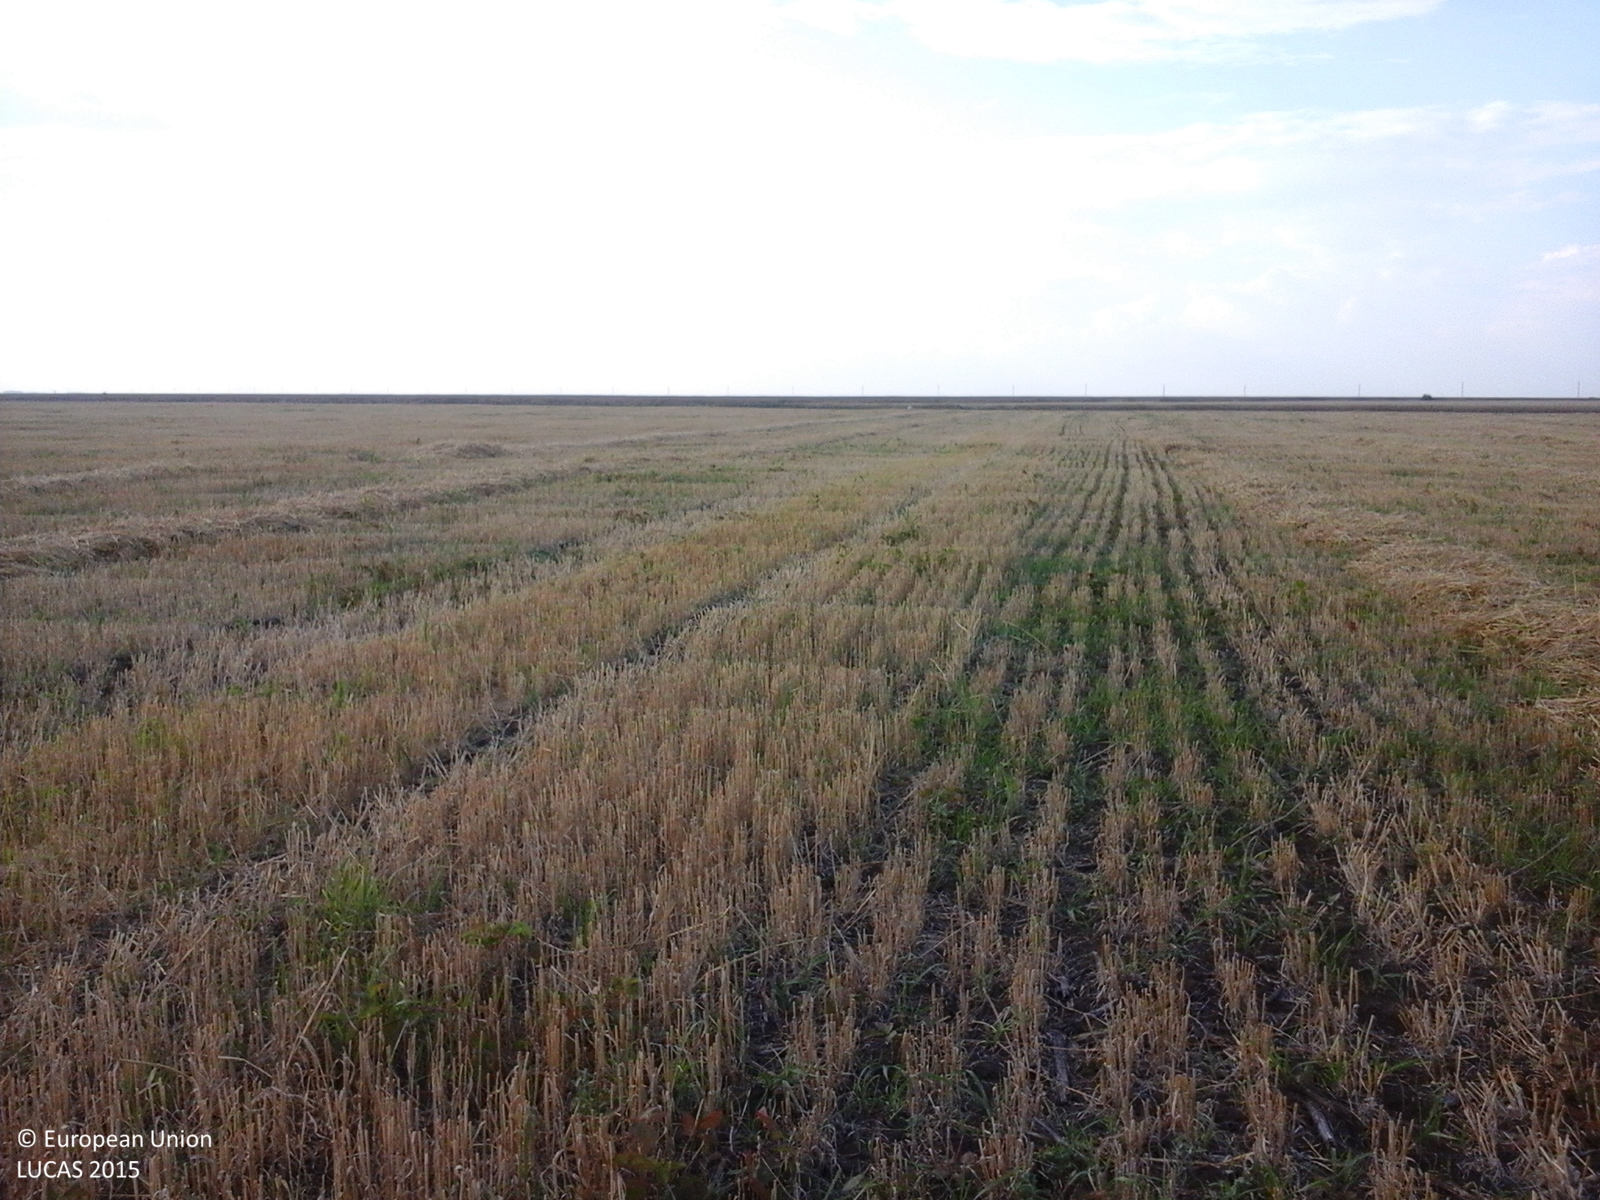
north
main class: Cropland
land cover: Rye
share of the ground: < 10 %
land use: Agriculture (excluding fallow land and kitchen gardens)
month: July
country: RO
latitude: 43.9669
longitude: 25.7339
